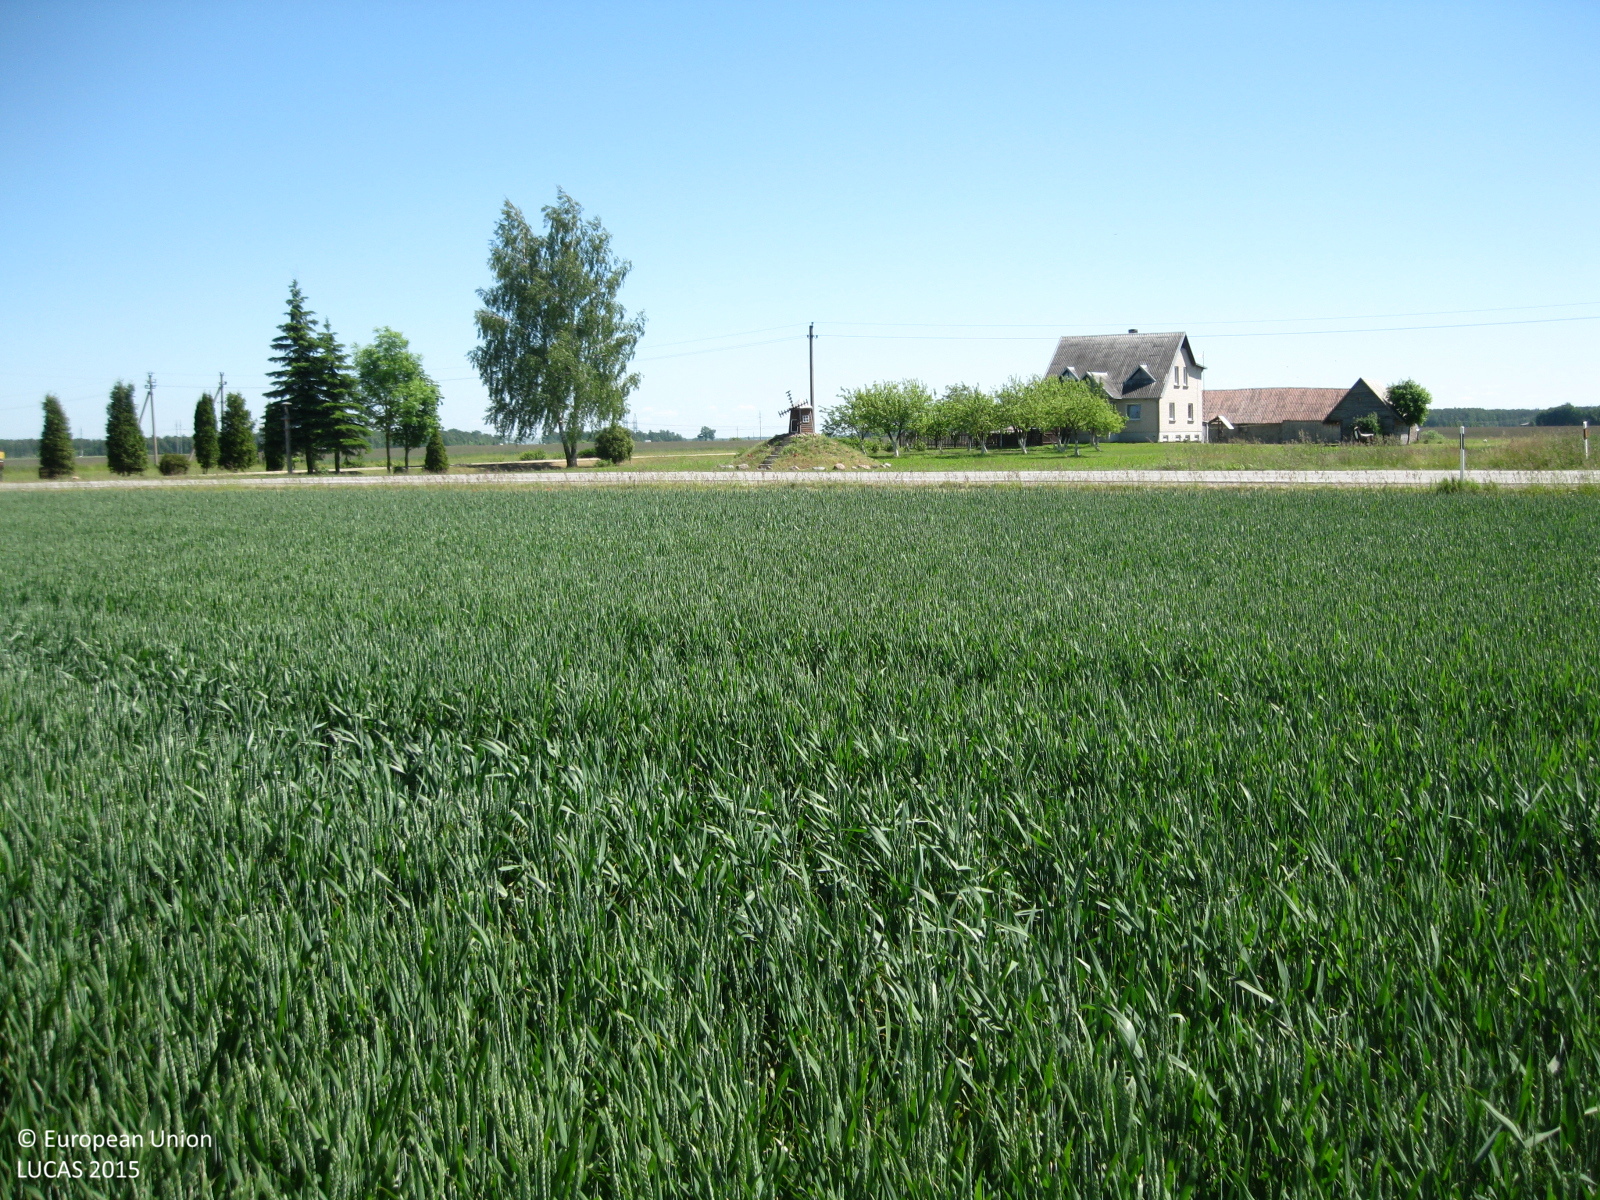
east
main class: Cropland
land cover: Common wheat
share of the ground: > 75 %
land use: Agriculture (excluding fallow land and kitchen gardens)
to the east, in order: Common wheat; Grassland without tree/shrub cover; Paved roads, cycling and walking lanes; Grassland without tree/shrub cover; Artificial constructions in urban areas; Grassland without tree/shrub cover; Managed hedges; Grass margins; Tracks; Grassland without tree/shrub cover; Electric lines; Grassland without tree/shrub cover; Common wheat
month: June
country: LT
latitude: 55.6779
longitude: 24.2633
